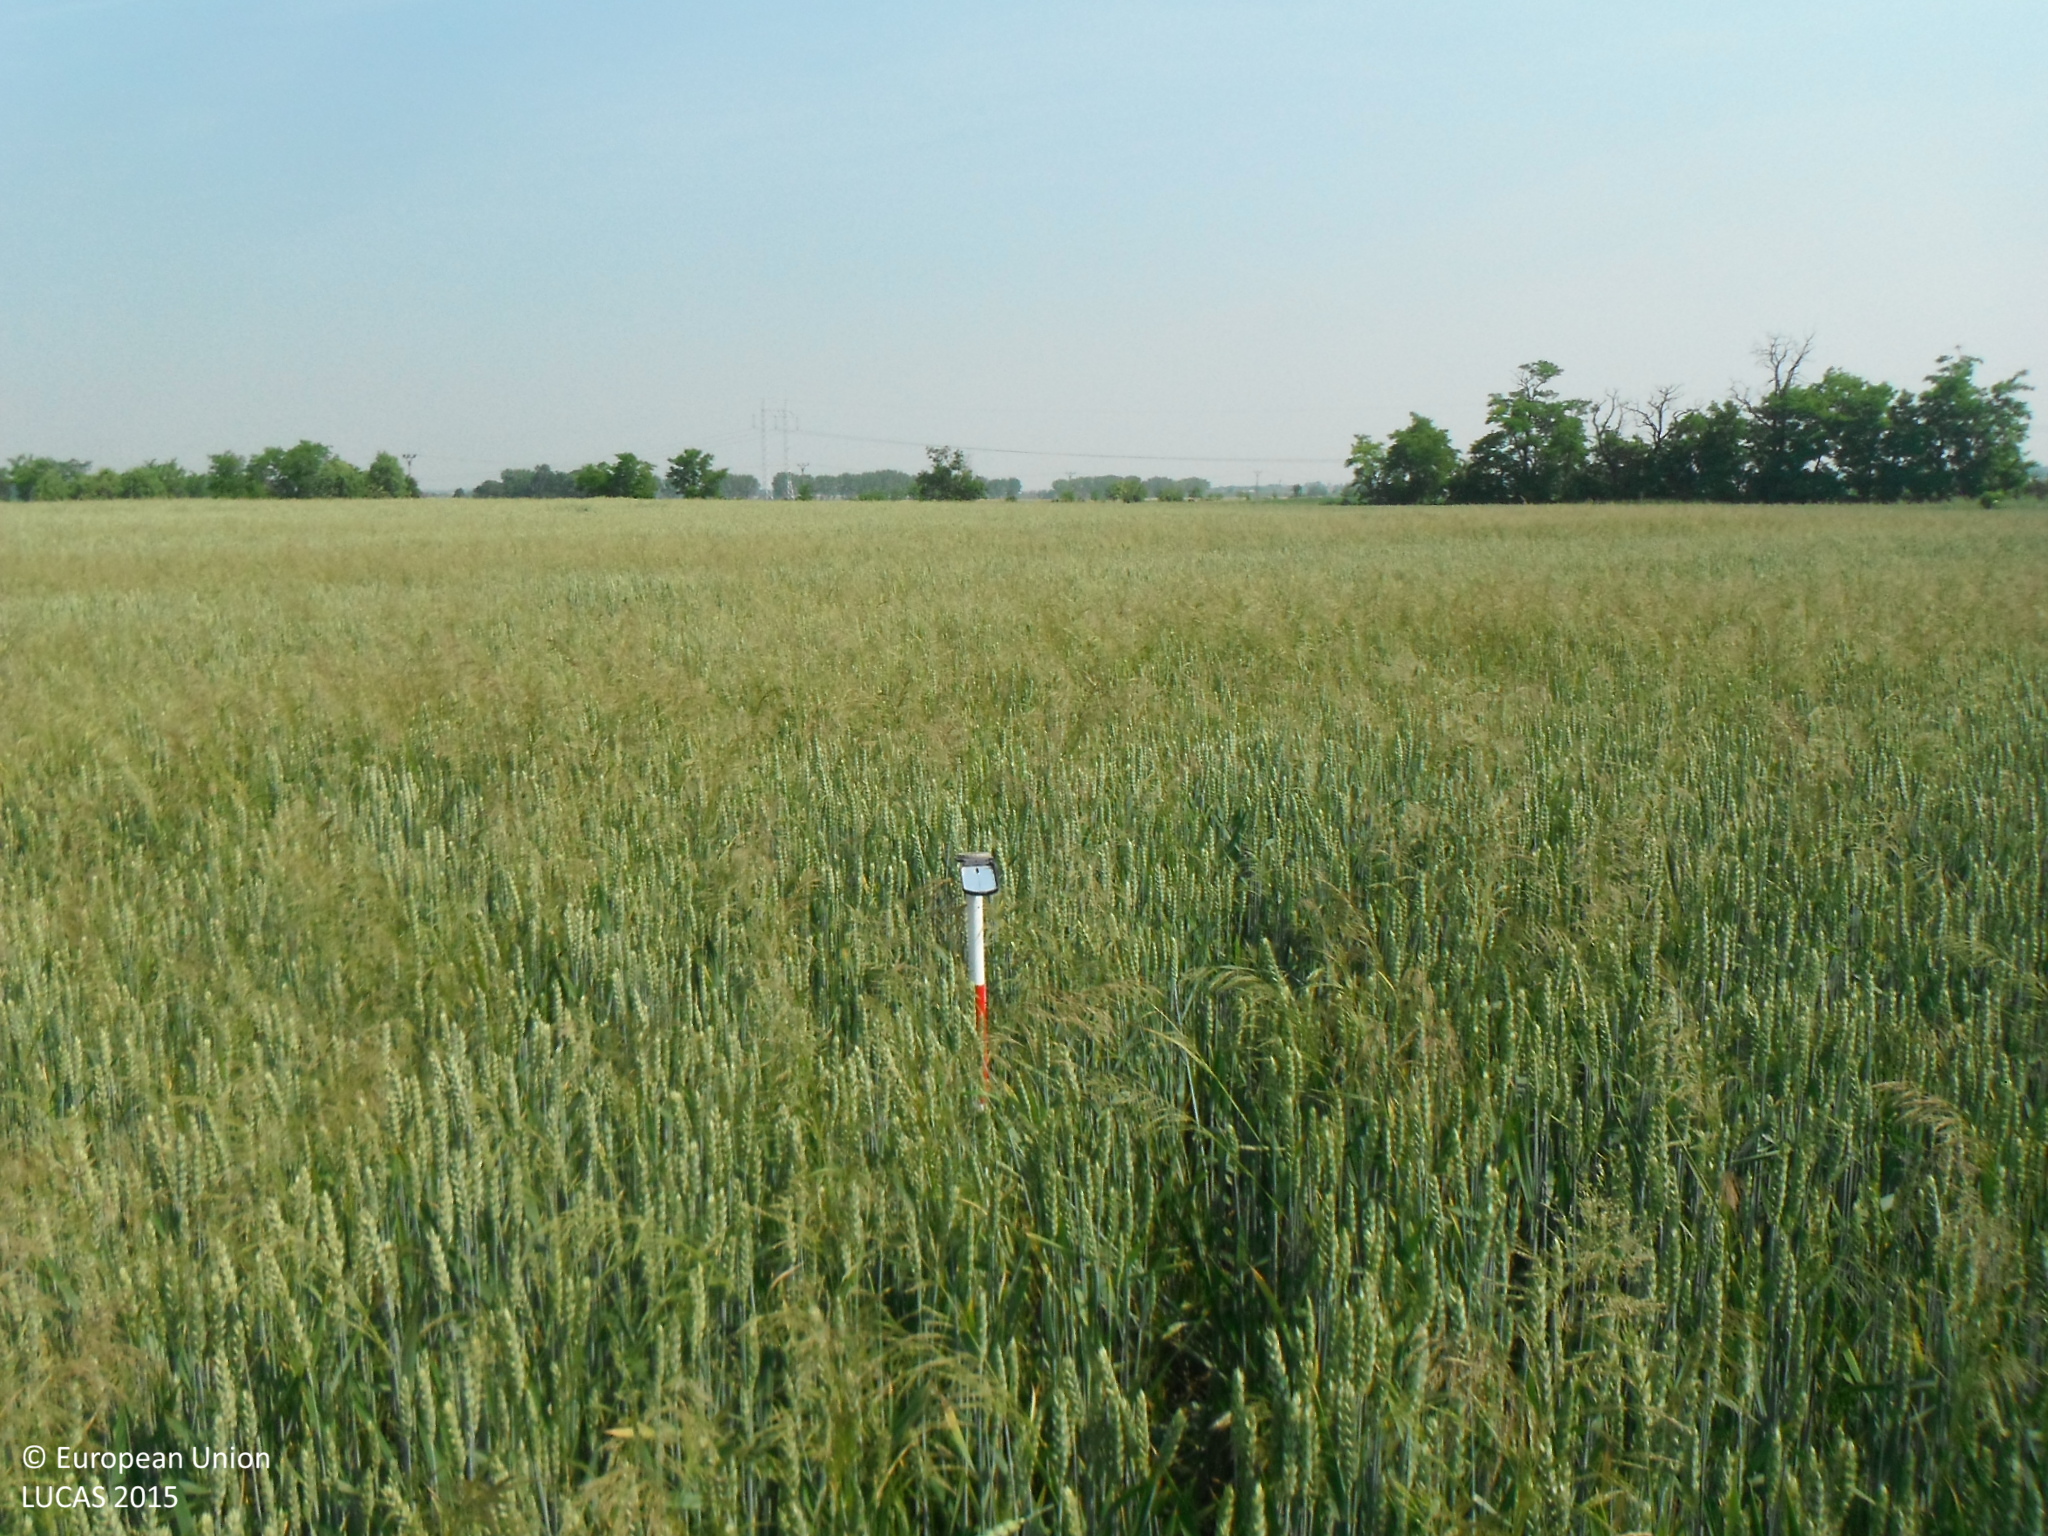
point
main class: Cropland
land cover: Common wheat
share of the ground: > 75 %
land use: Agriculture (excluding fallow land and kitchen gardens)
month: June
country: SK
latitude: 48.1922
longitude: 17.9089
